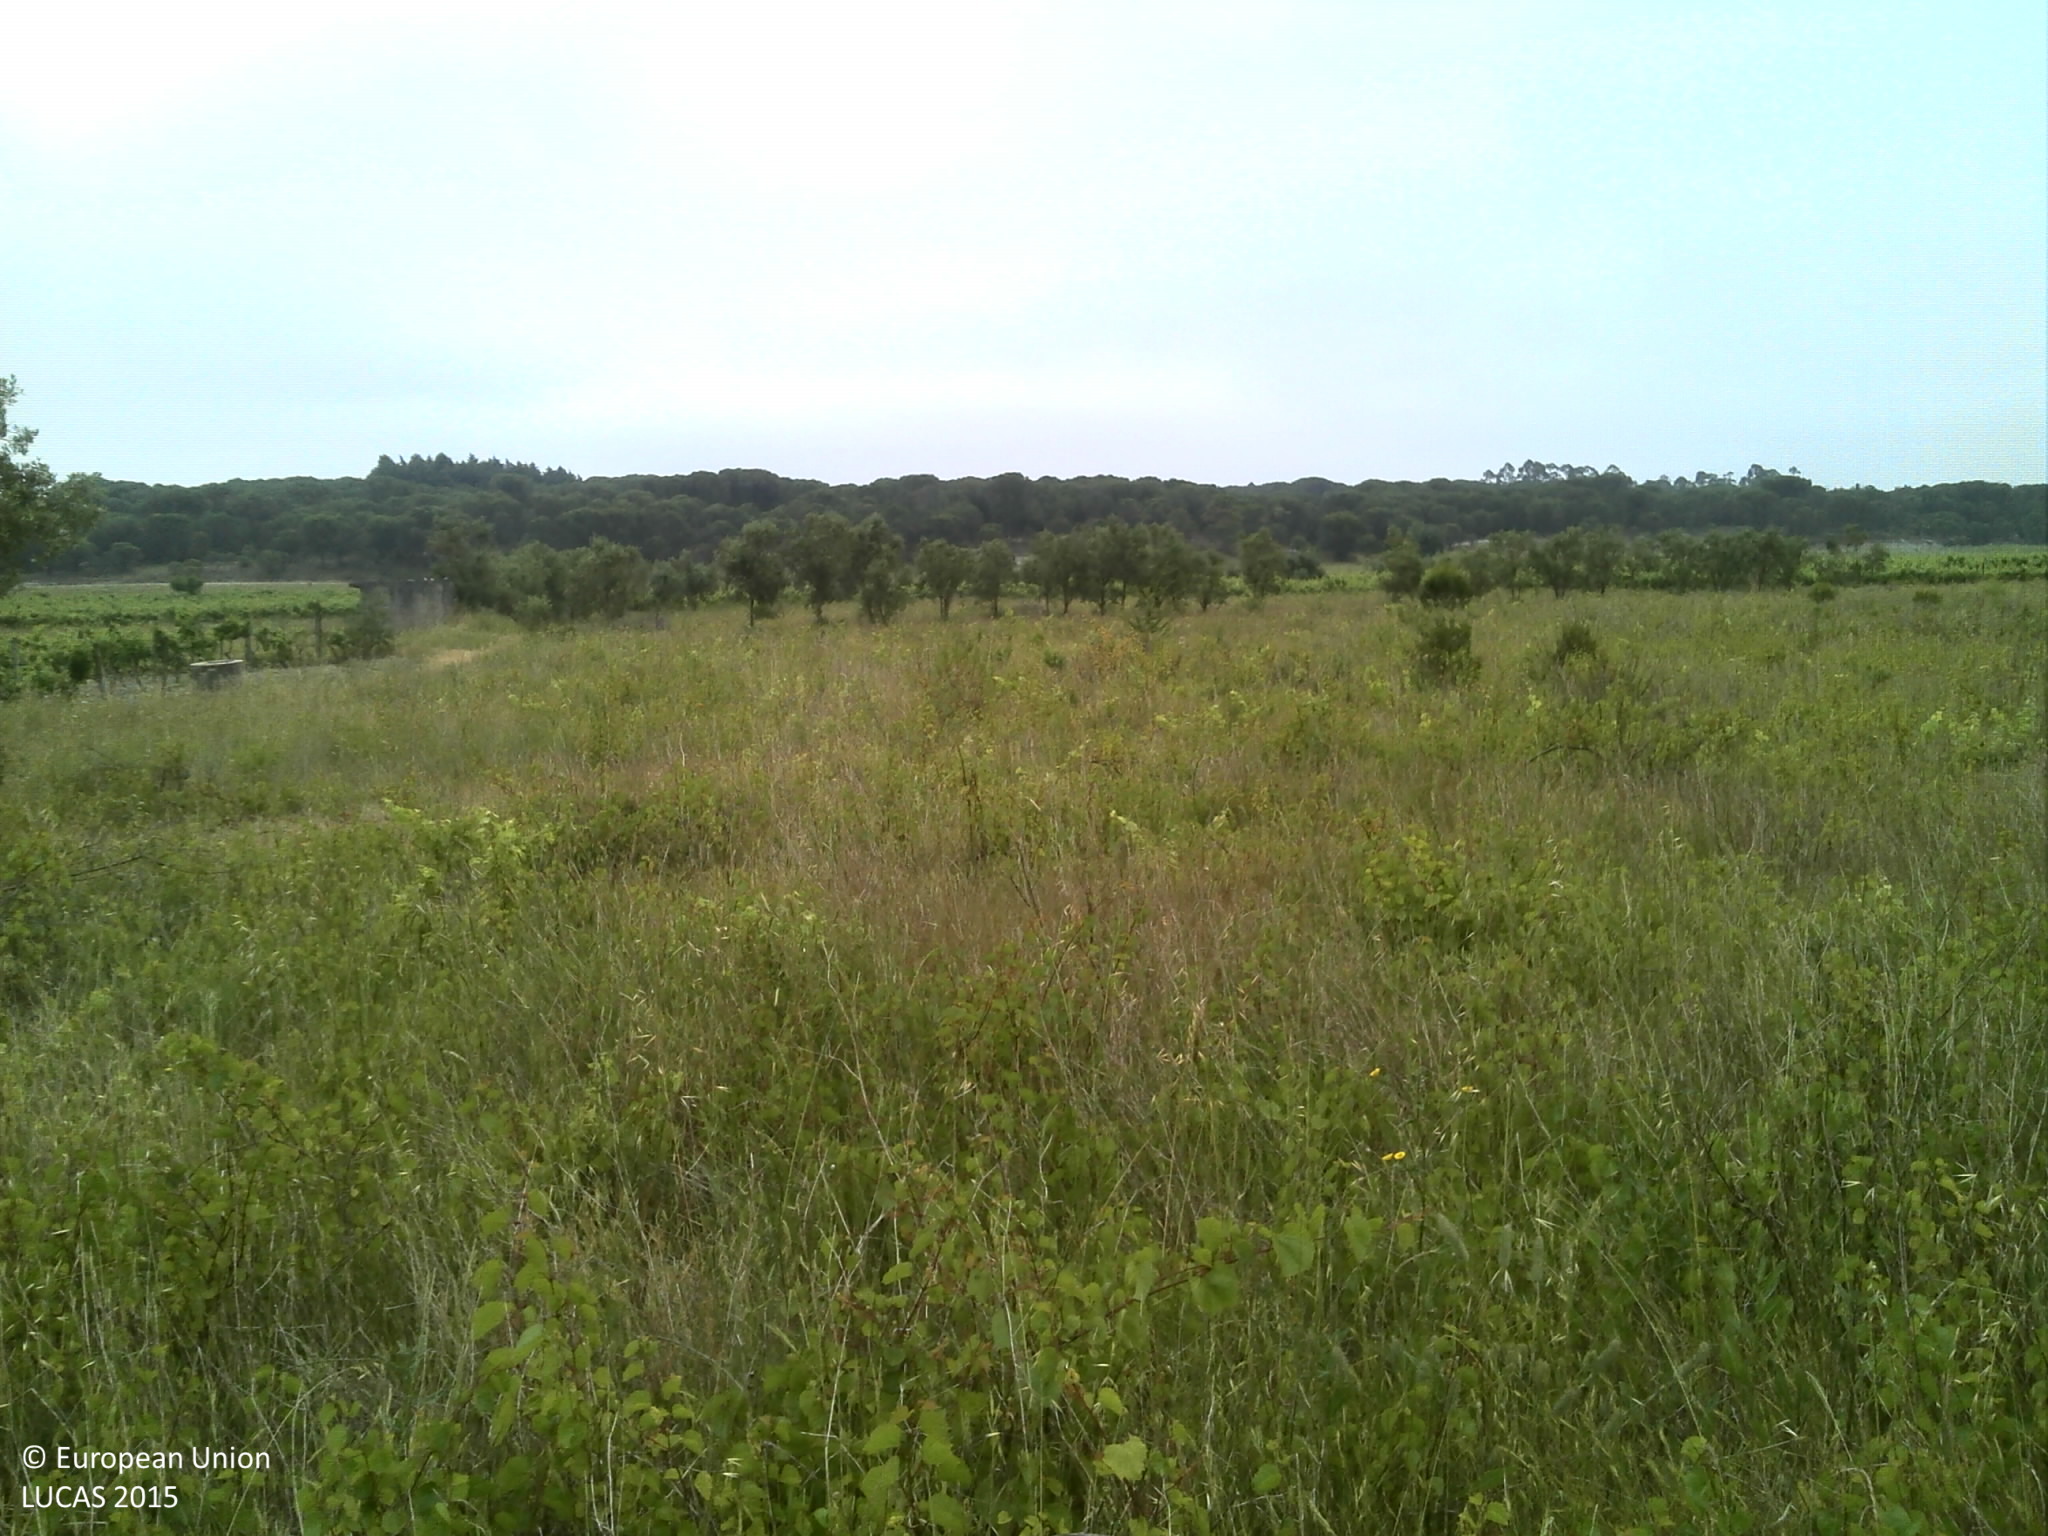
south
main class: Cropland
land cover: Vineyards
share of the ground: 10 - 25 %
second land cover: Grassland without tree/shrub cover
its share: 50 - 75 %
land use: Abandoned areas
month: June
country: PT
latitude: 40.3208
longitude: -8.6024
